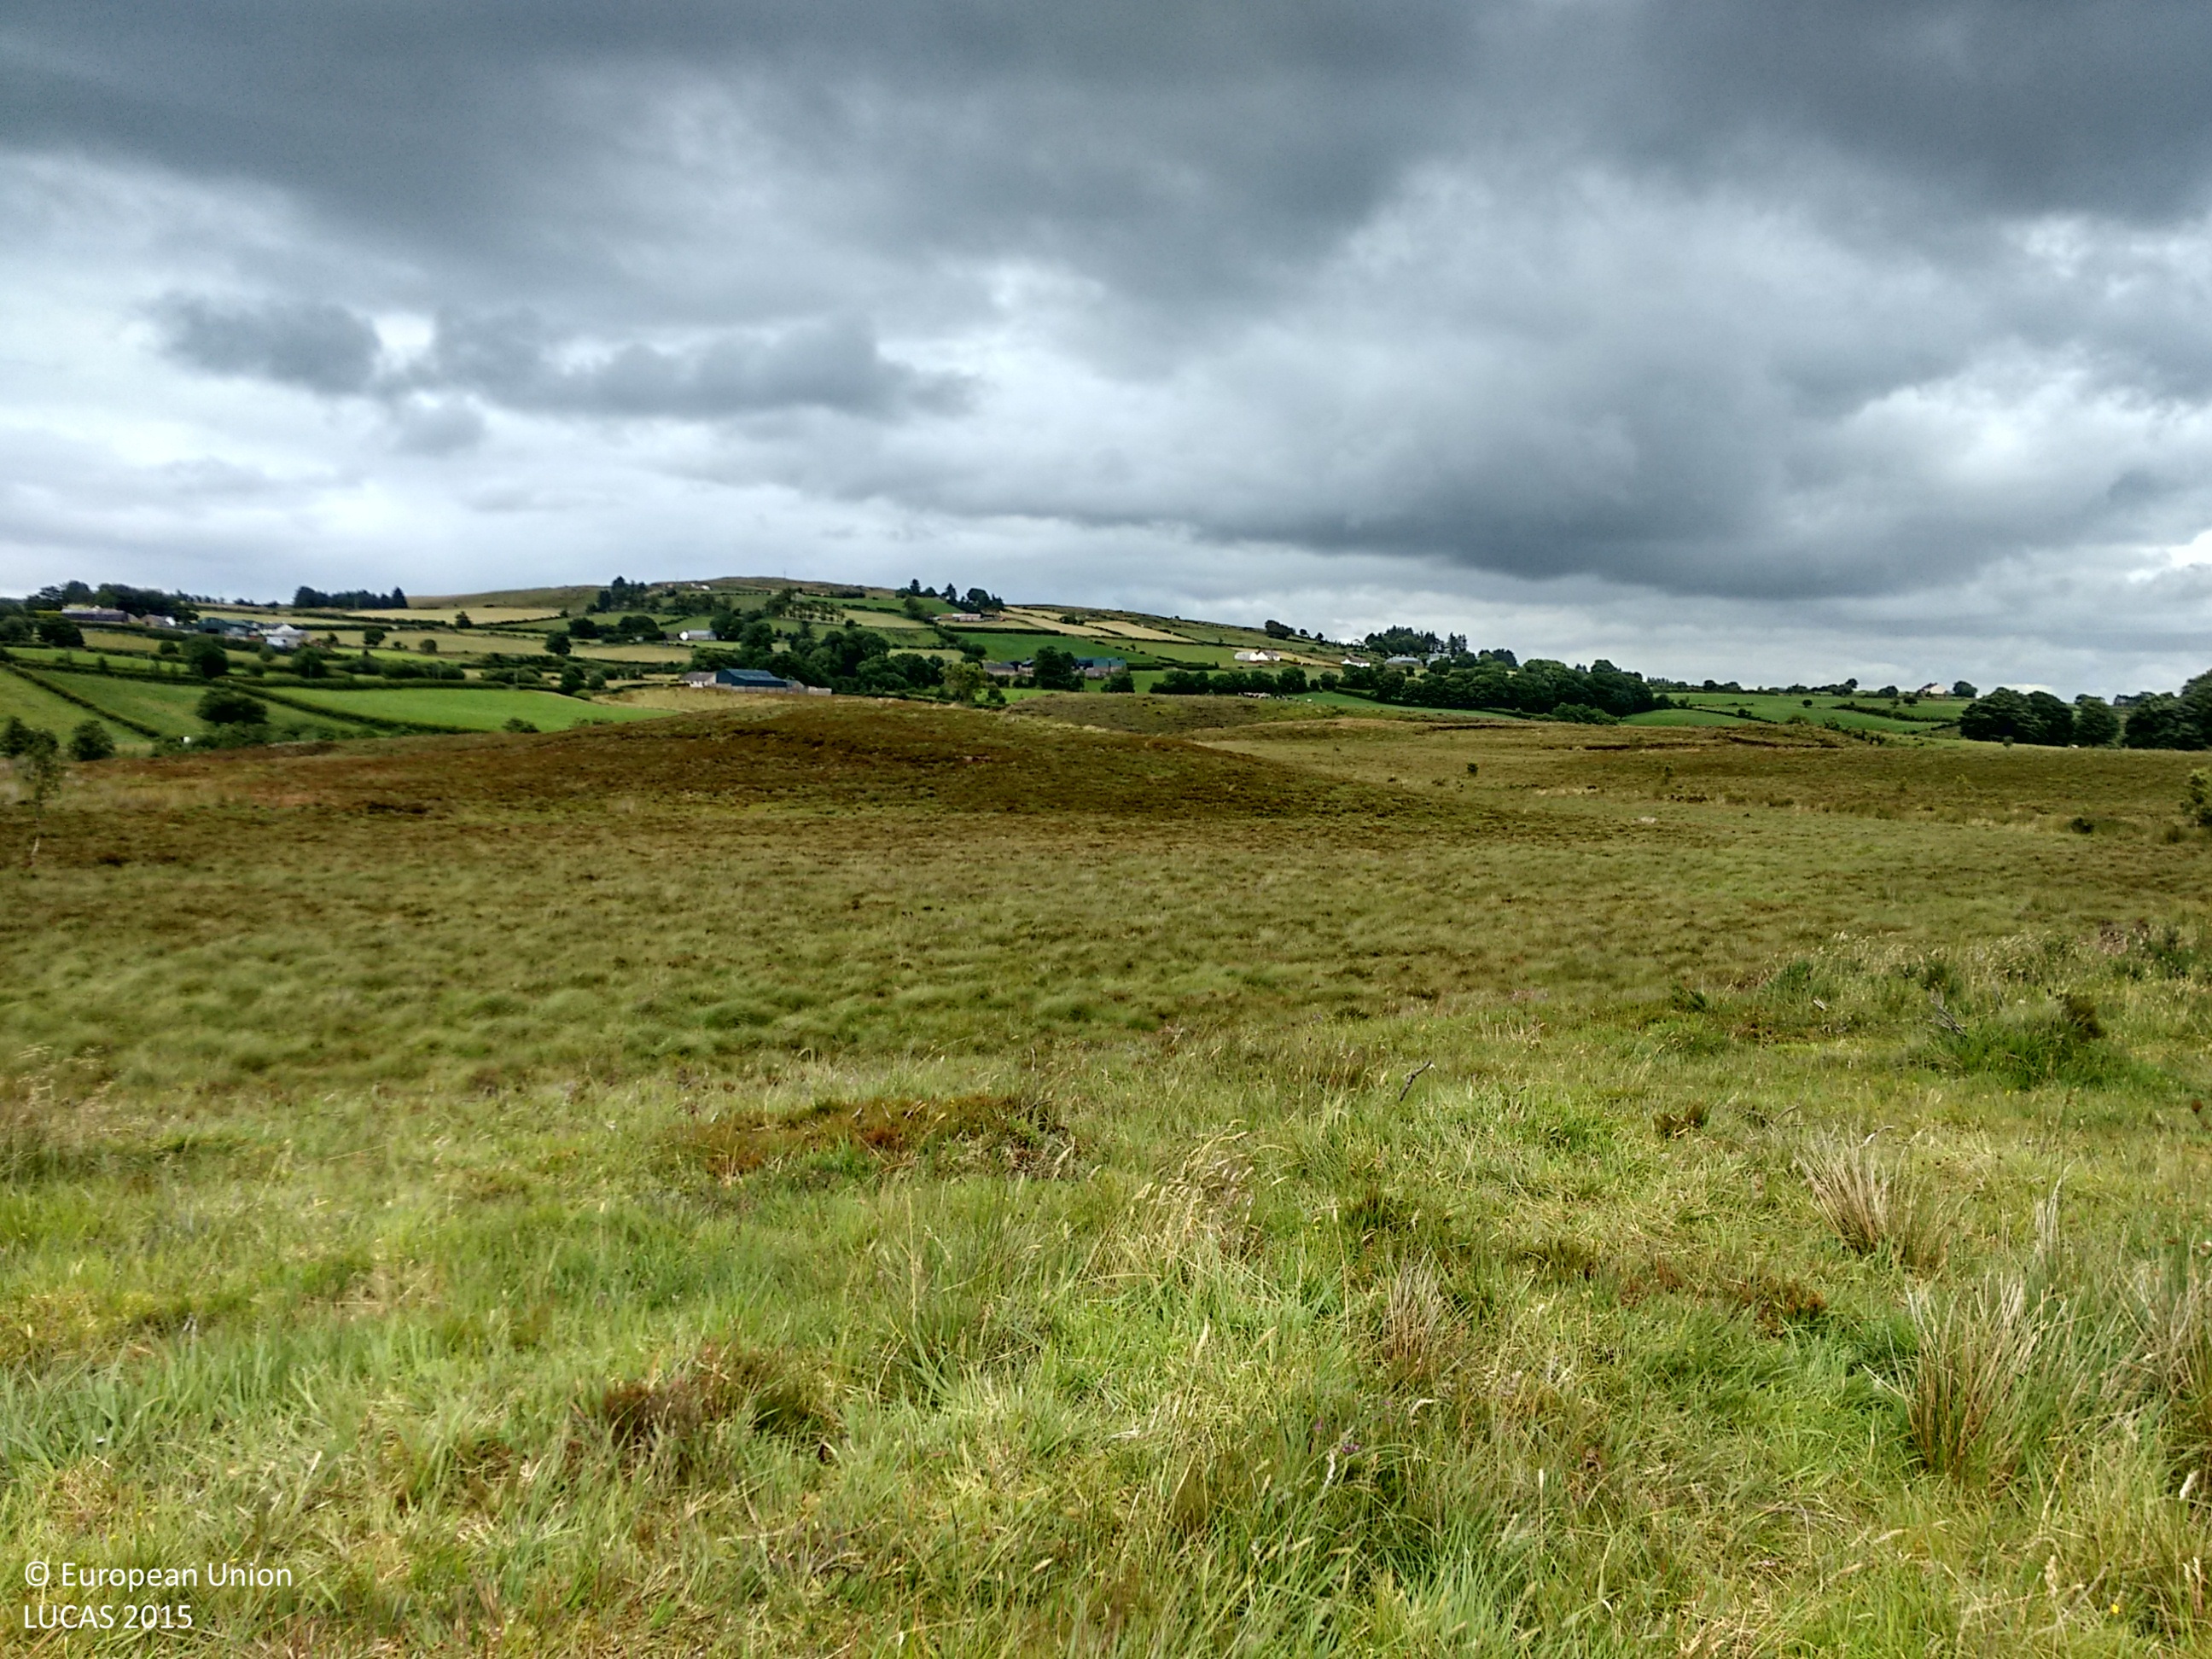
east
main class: Grassland
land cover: Grassland without tree/shrub cover
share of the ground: > 75 %
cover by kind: herbaceous plants 100 %
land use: Agriculture (excluding fallow land and kitchen gardens)
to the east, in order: Grassland without tree/shrub cover; Peatbogs
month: July
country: GB
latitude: 54.6384
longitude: -7.1083
